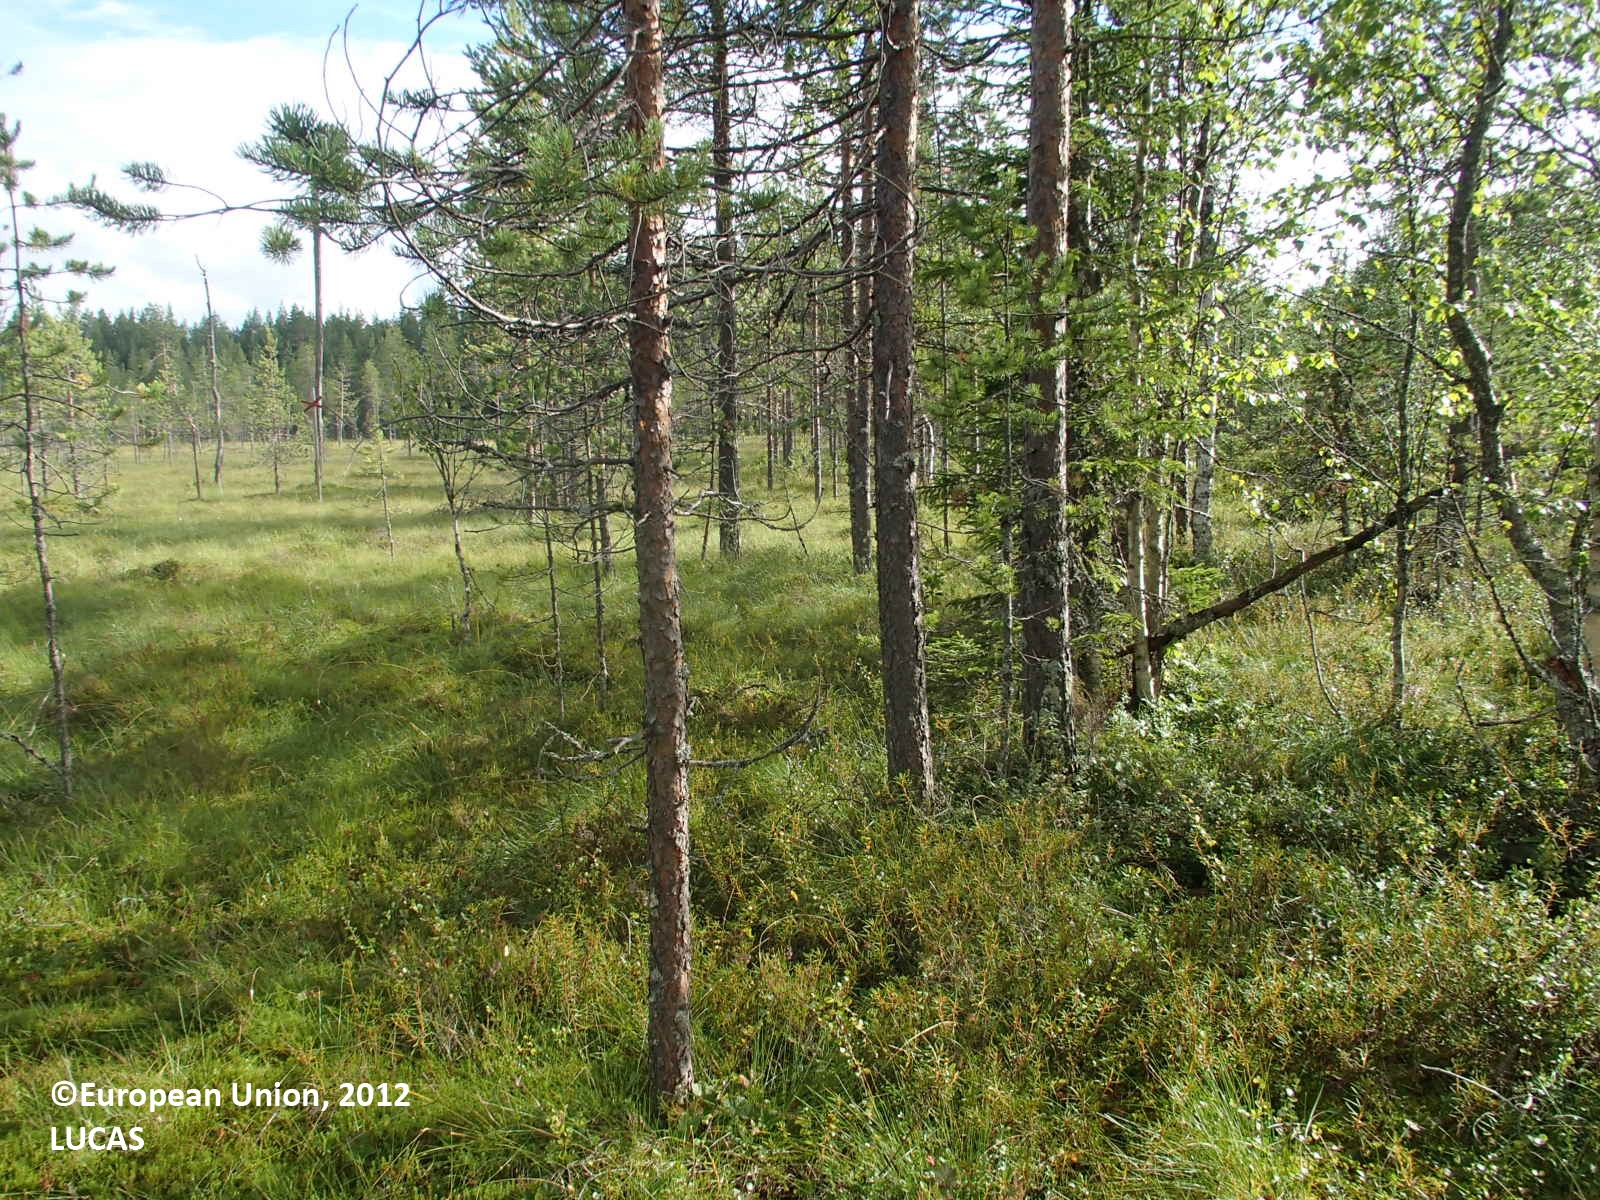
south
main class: Woodland
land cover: Pine dominated mixed woodland
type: boreal forest
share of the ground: 25 - 50 %
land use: Forestry
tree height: > 5 m
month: August
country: FI
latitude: 63.8384
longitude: 28.1641
